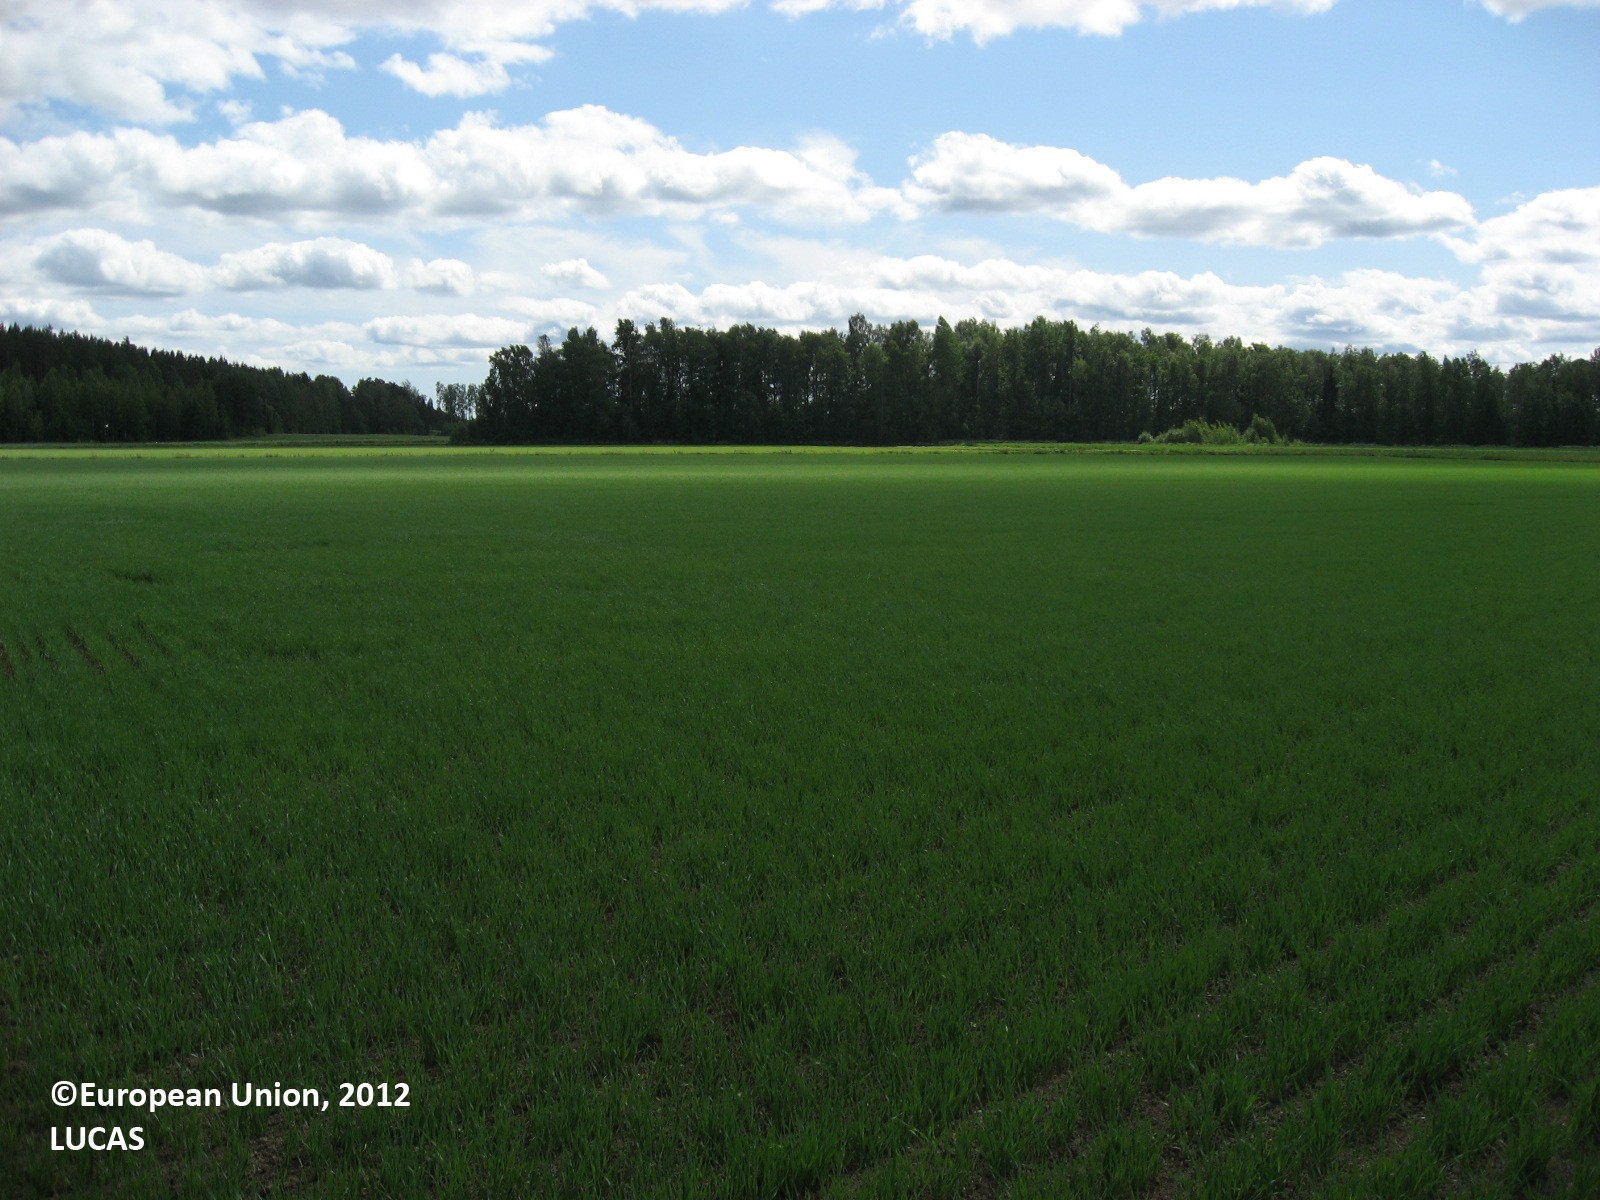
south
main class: Cropland
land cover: Temporary grasslands
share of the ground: > 75 %
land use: Agriculture (excluding fallow land and kitchen gardens)
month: June
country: FI
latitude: 60.6187
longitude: 26.5091
